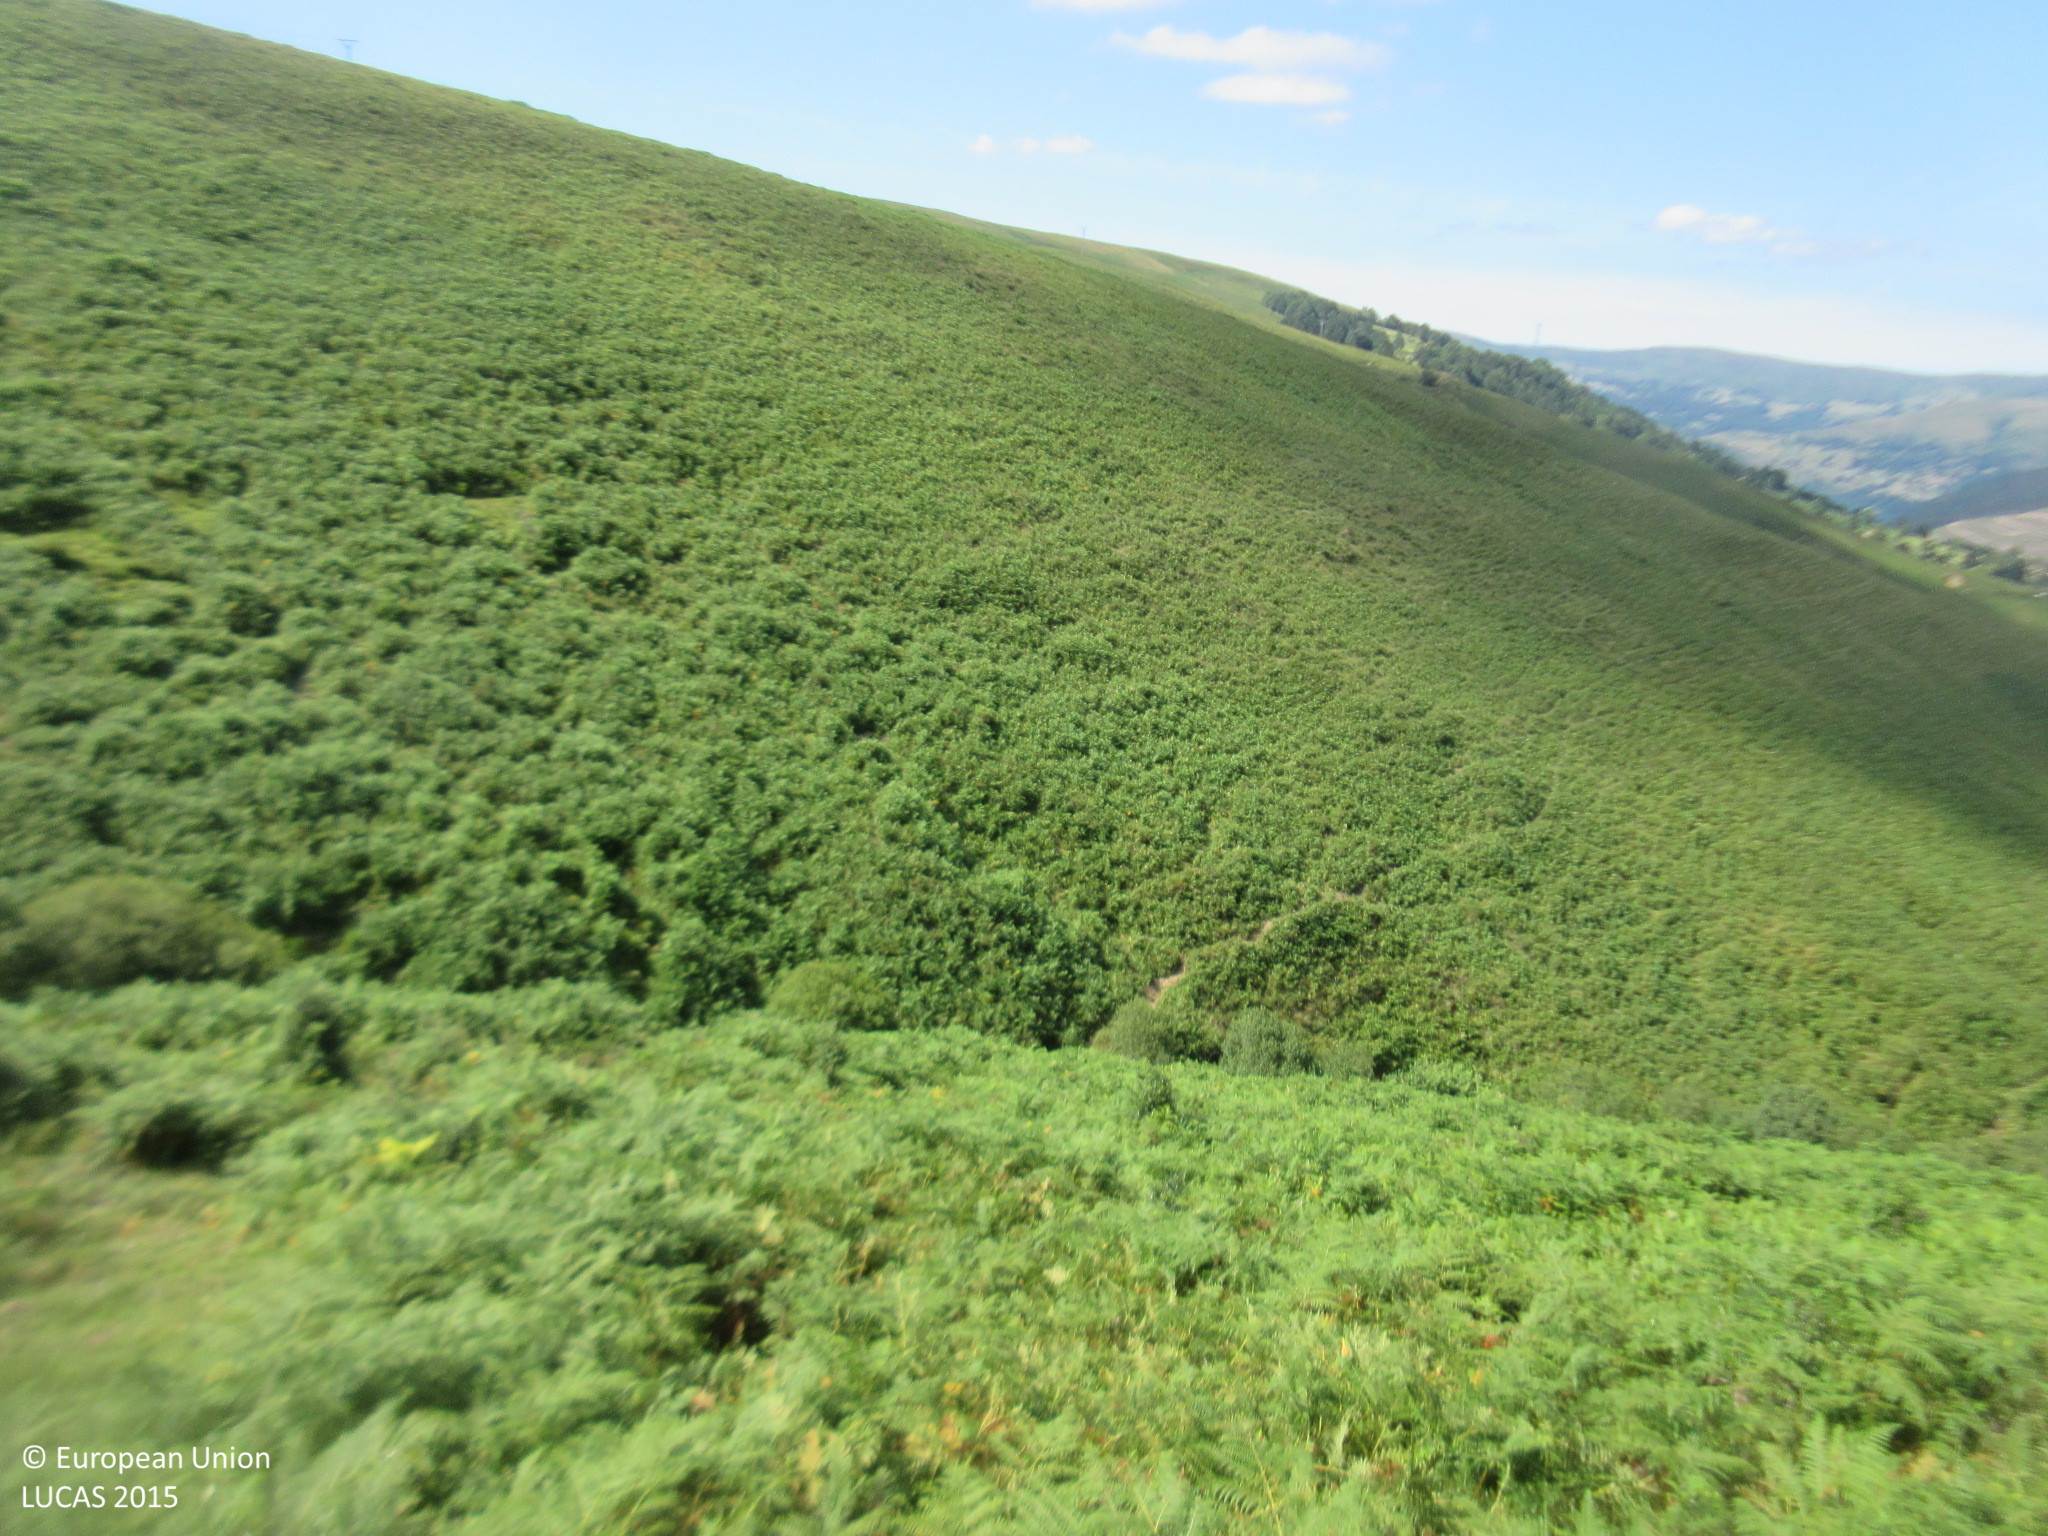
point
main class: Grassland
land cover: Grassland without tree/shrub cover
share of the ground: > 75 %
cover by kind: herbaceous plants 100 %
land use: Agriculture (excluding fallow land and kitchen gardens)
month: July
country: ES
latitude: 43.1208
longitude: -3.8742
